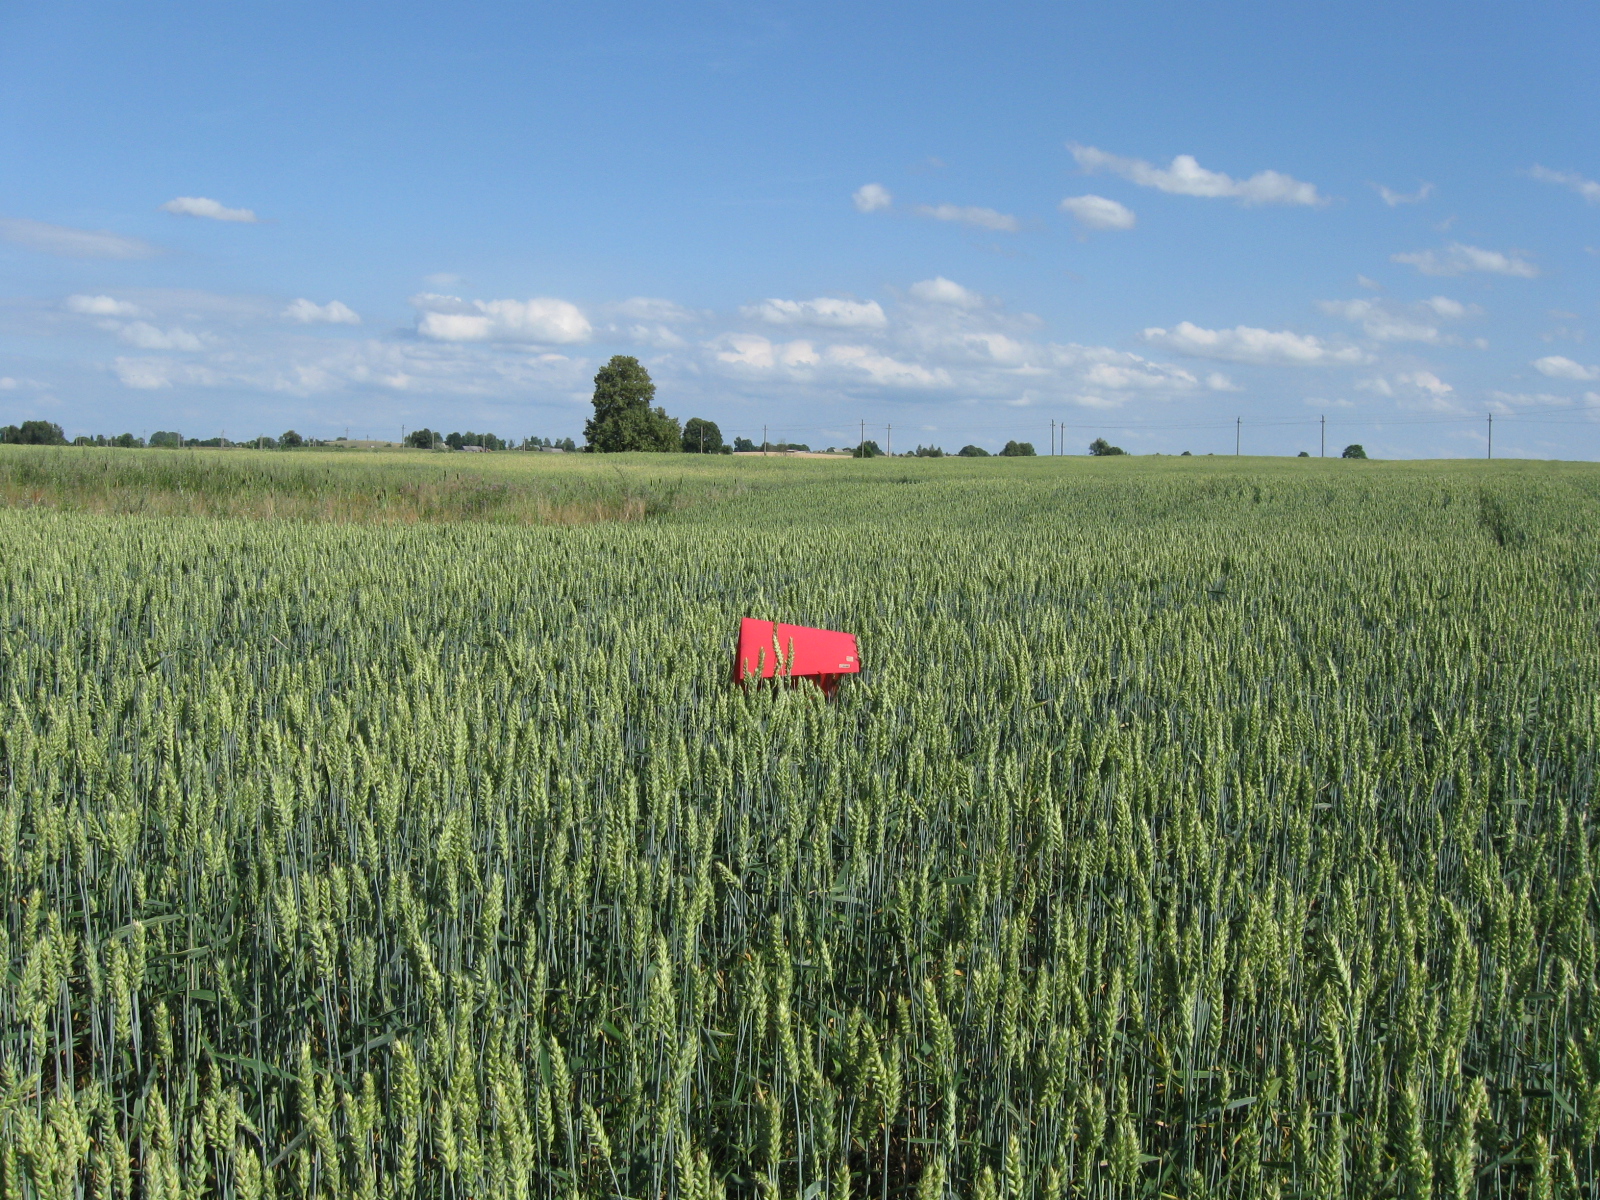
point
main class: Cropland
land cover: Common wheat
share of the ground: > 75 %
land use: Agriculture (excluding fallow land and kitchen gardens)
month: July
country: LT
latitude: 54.3295
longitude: 23.4128
